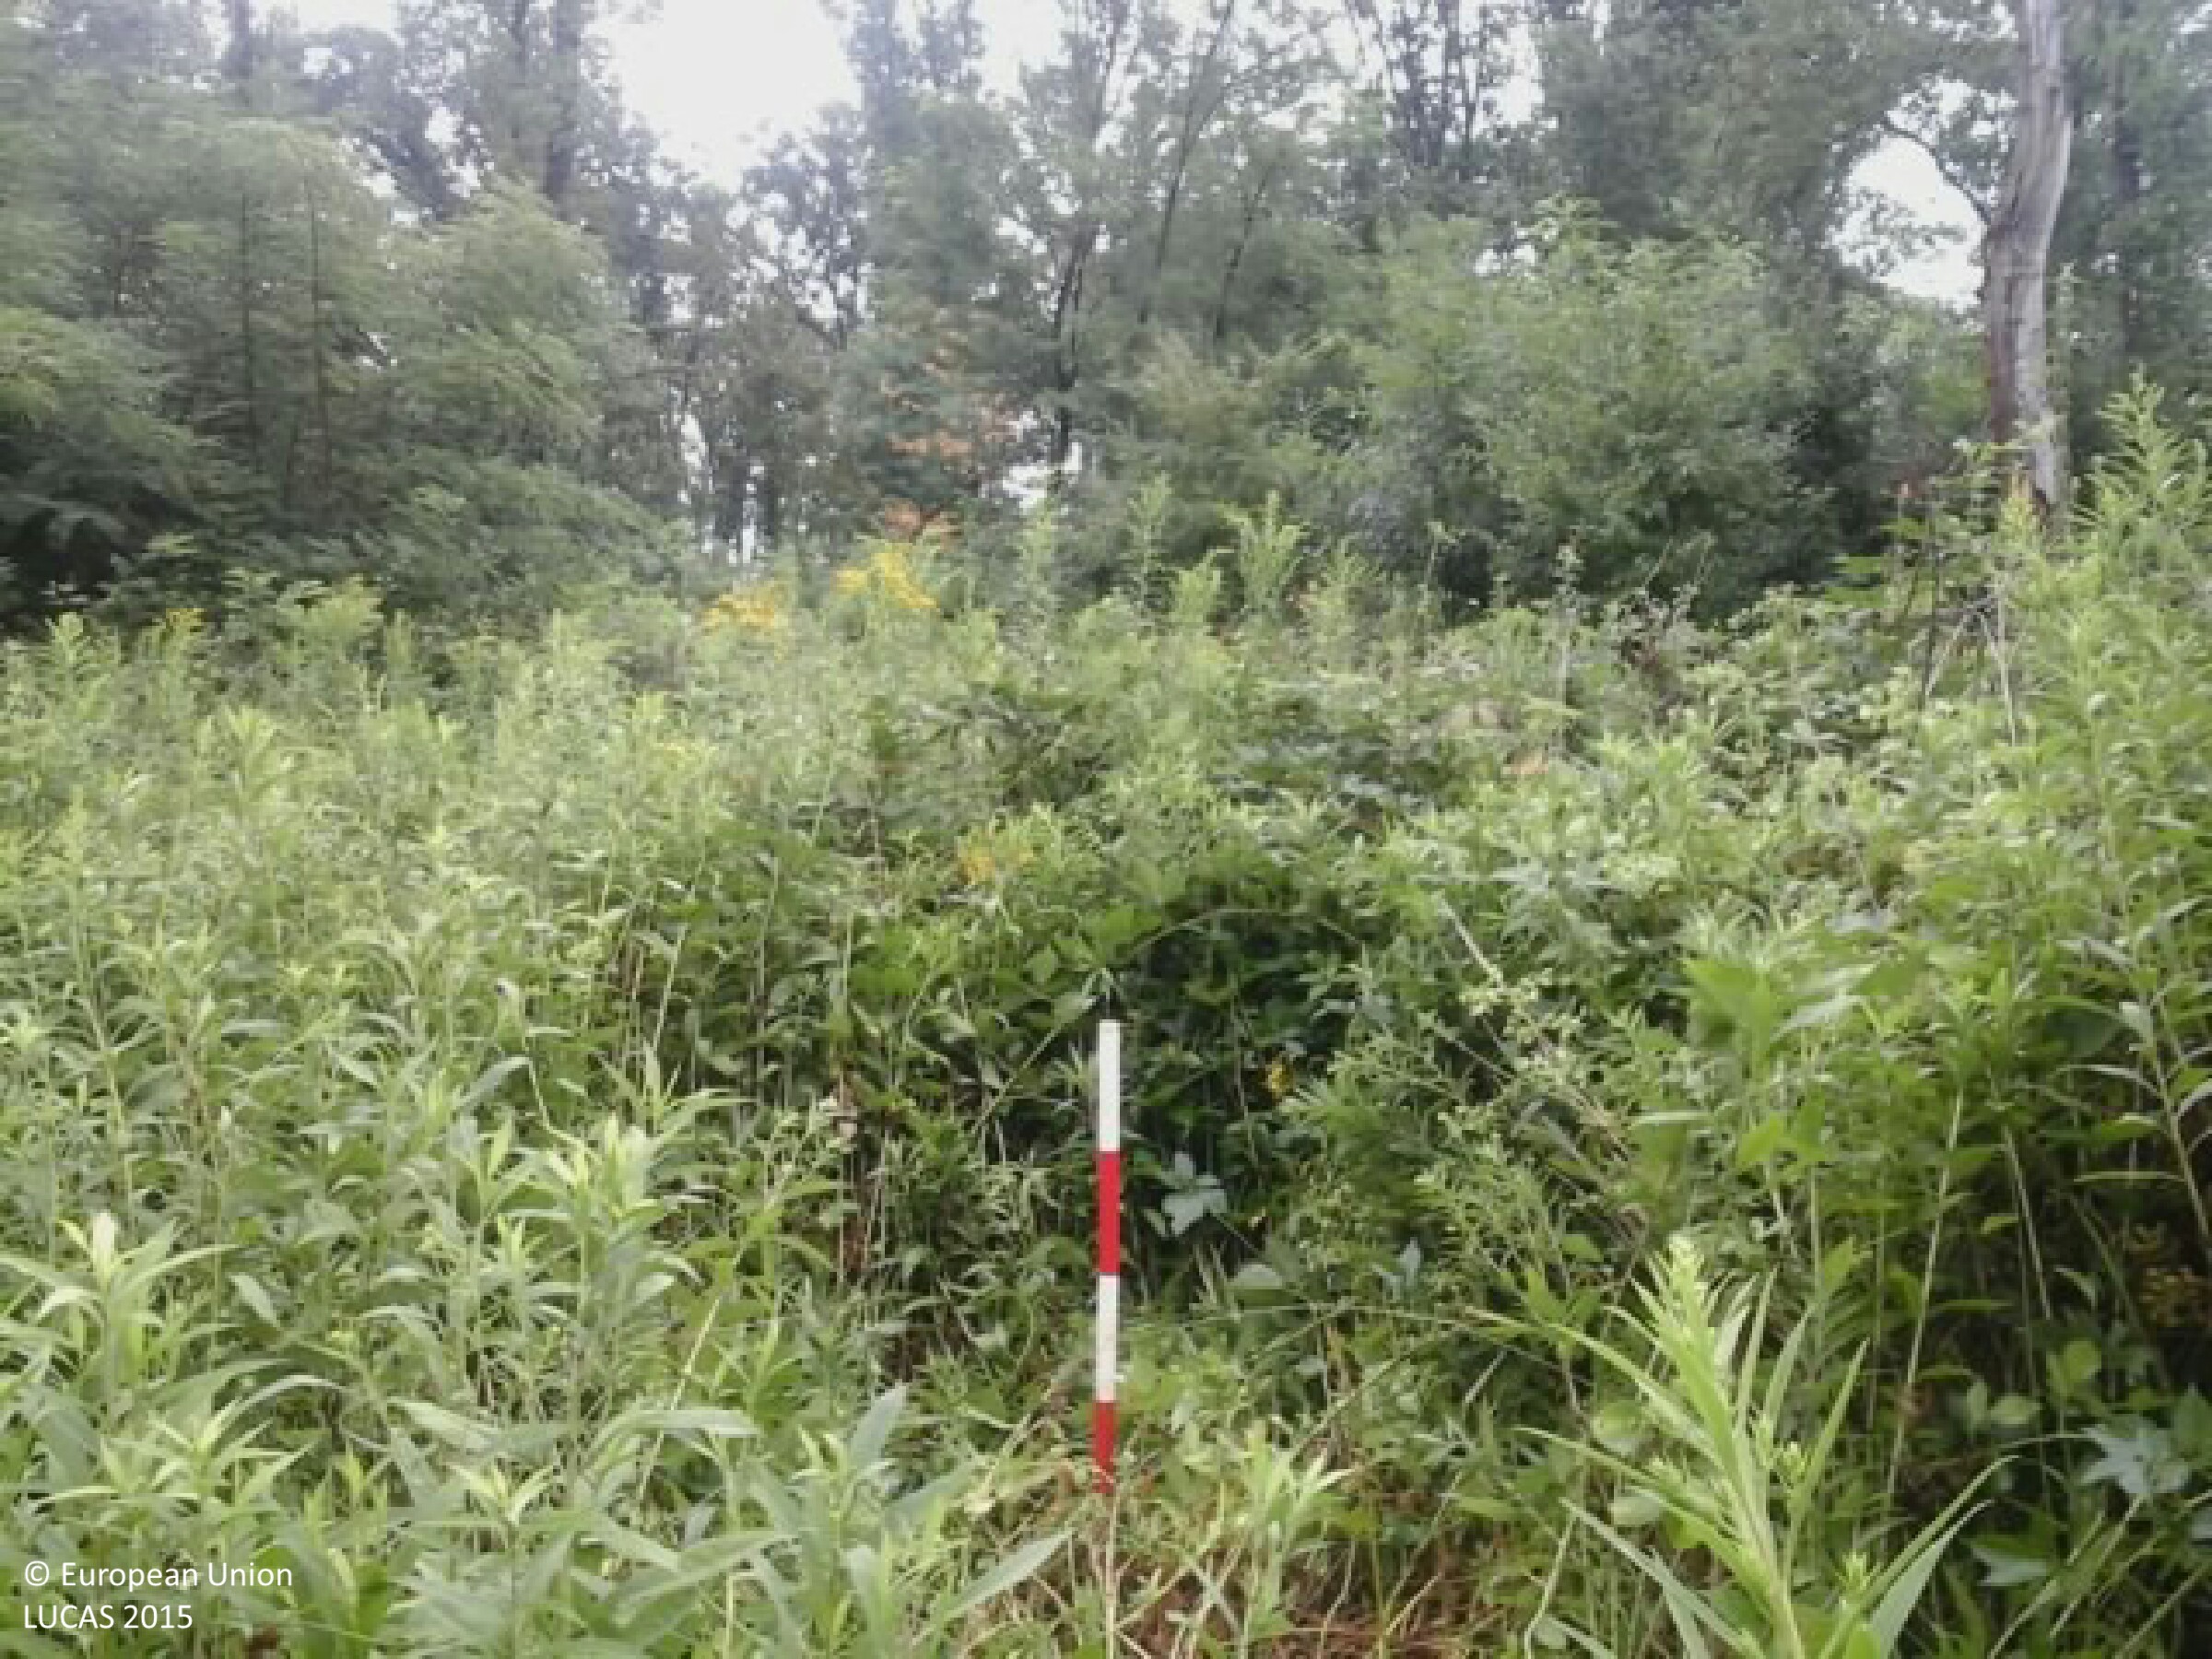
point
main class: Shrubland
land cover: Shrubland without tree cover
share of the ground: 50 - 75 %
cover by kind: shrubs 65 %, herbaceous plants 35 %
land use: Forestry
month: July
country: HU
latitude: 46.3910
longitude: 17.2991
